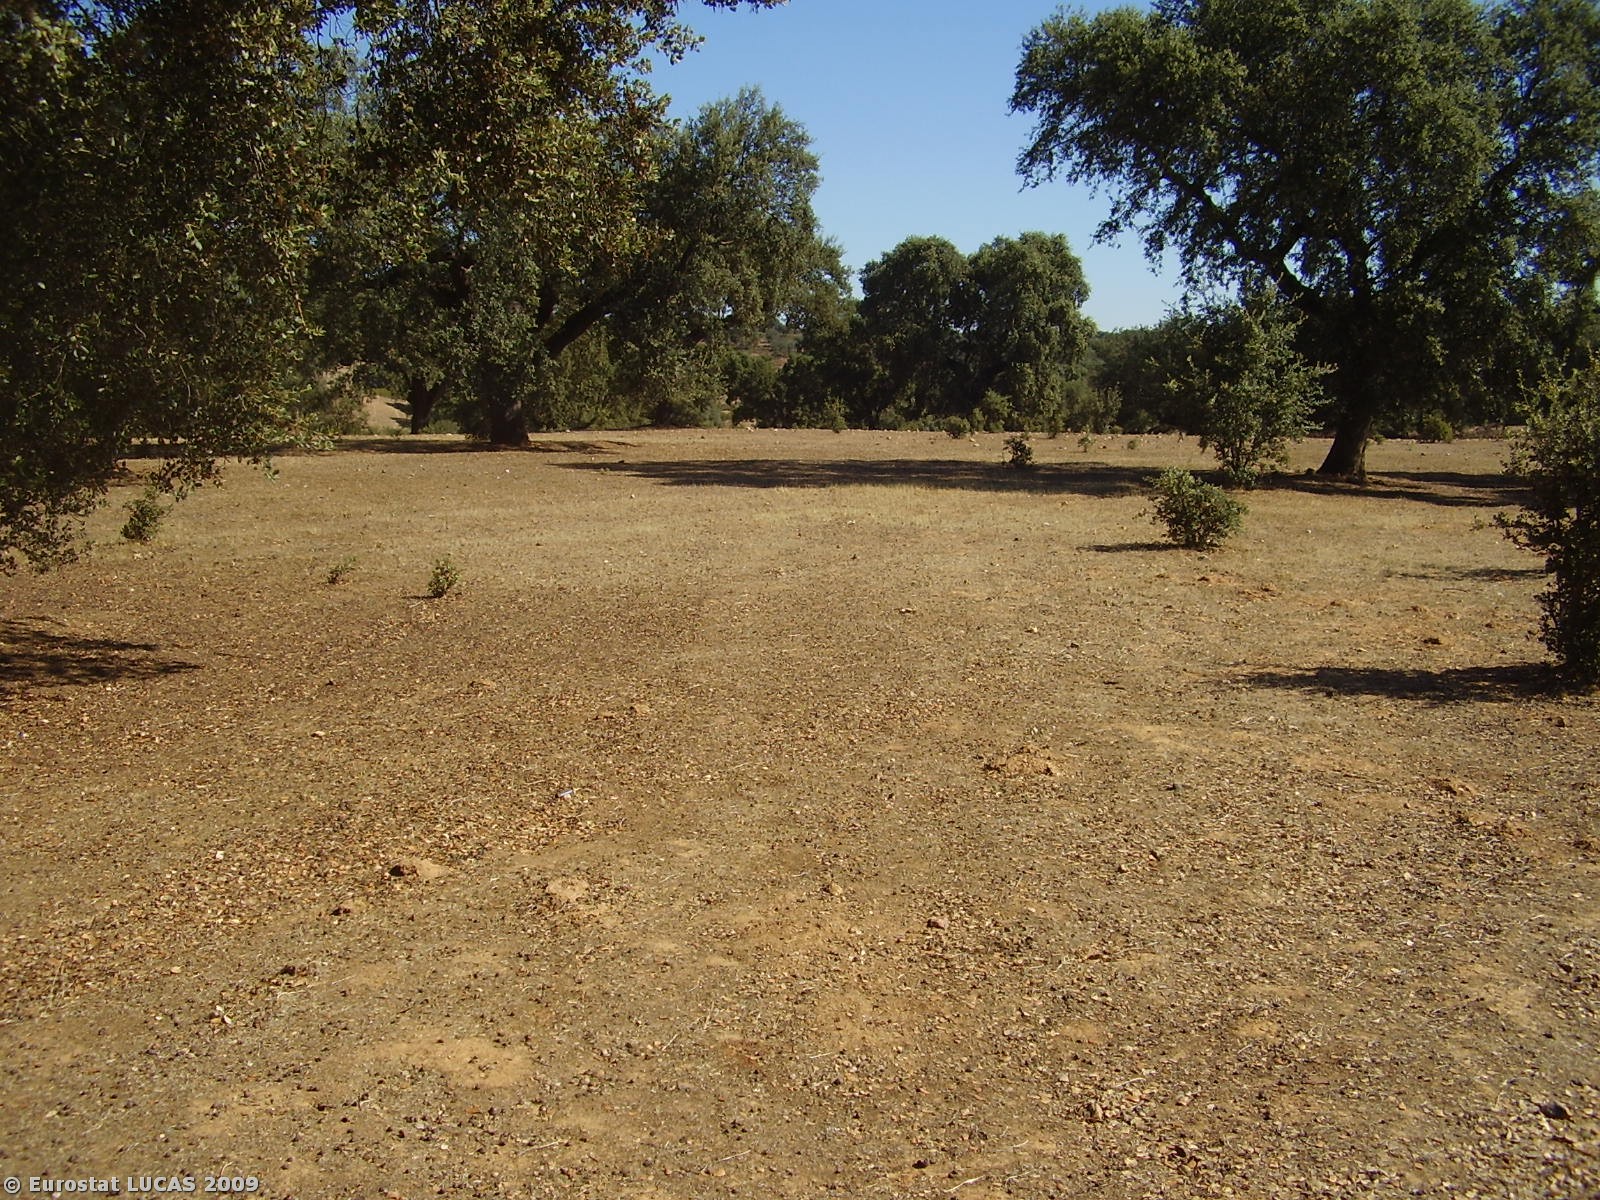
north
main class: Woodland
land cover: Broadleaved woodland
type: broadleaved evergreen forest
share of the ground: 10 - 25 %
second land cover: Bare land
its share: 50 - 75 %
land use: Forestry
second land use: Fallow land
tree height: > 5 m
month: July
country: PT
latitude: 38.8779
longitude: -7.8294
